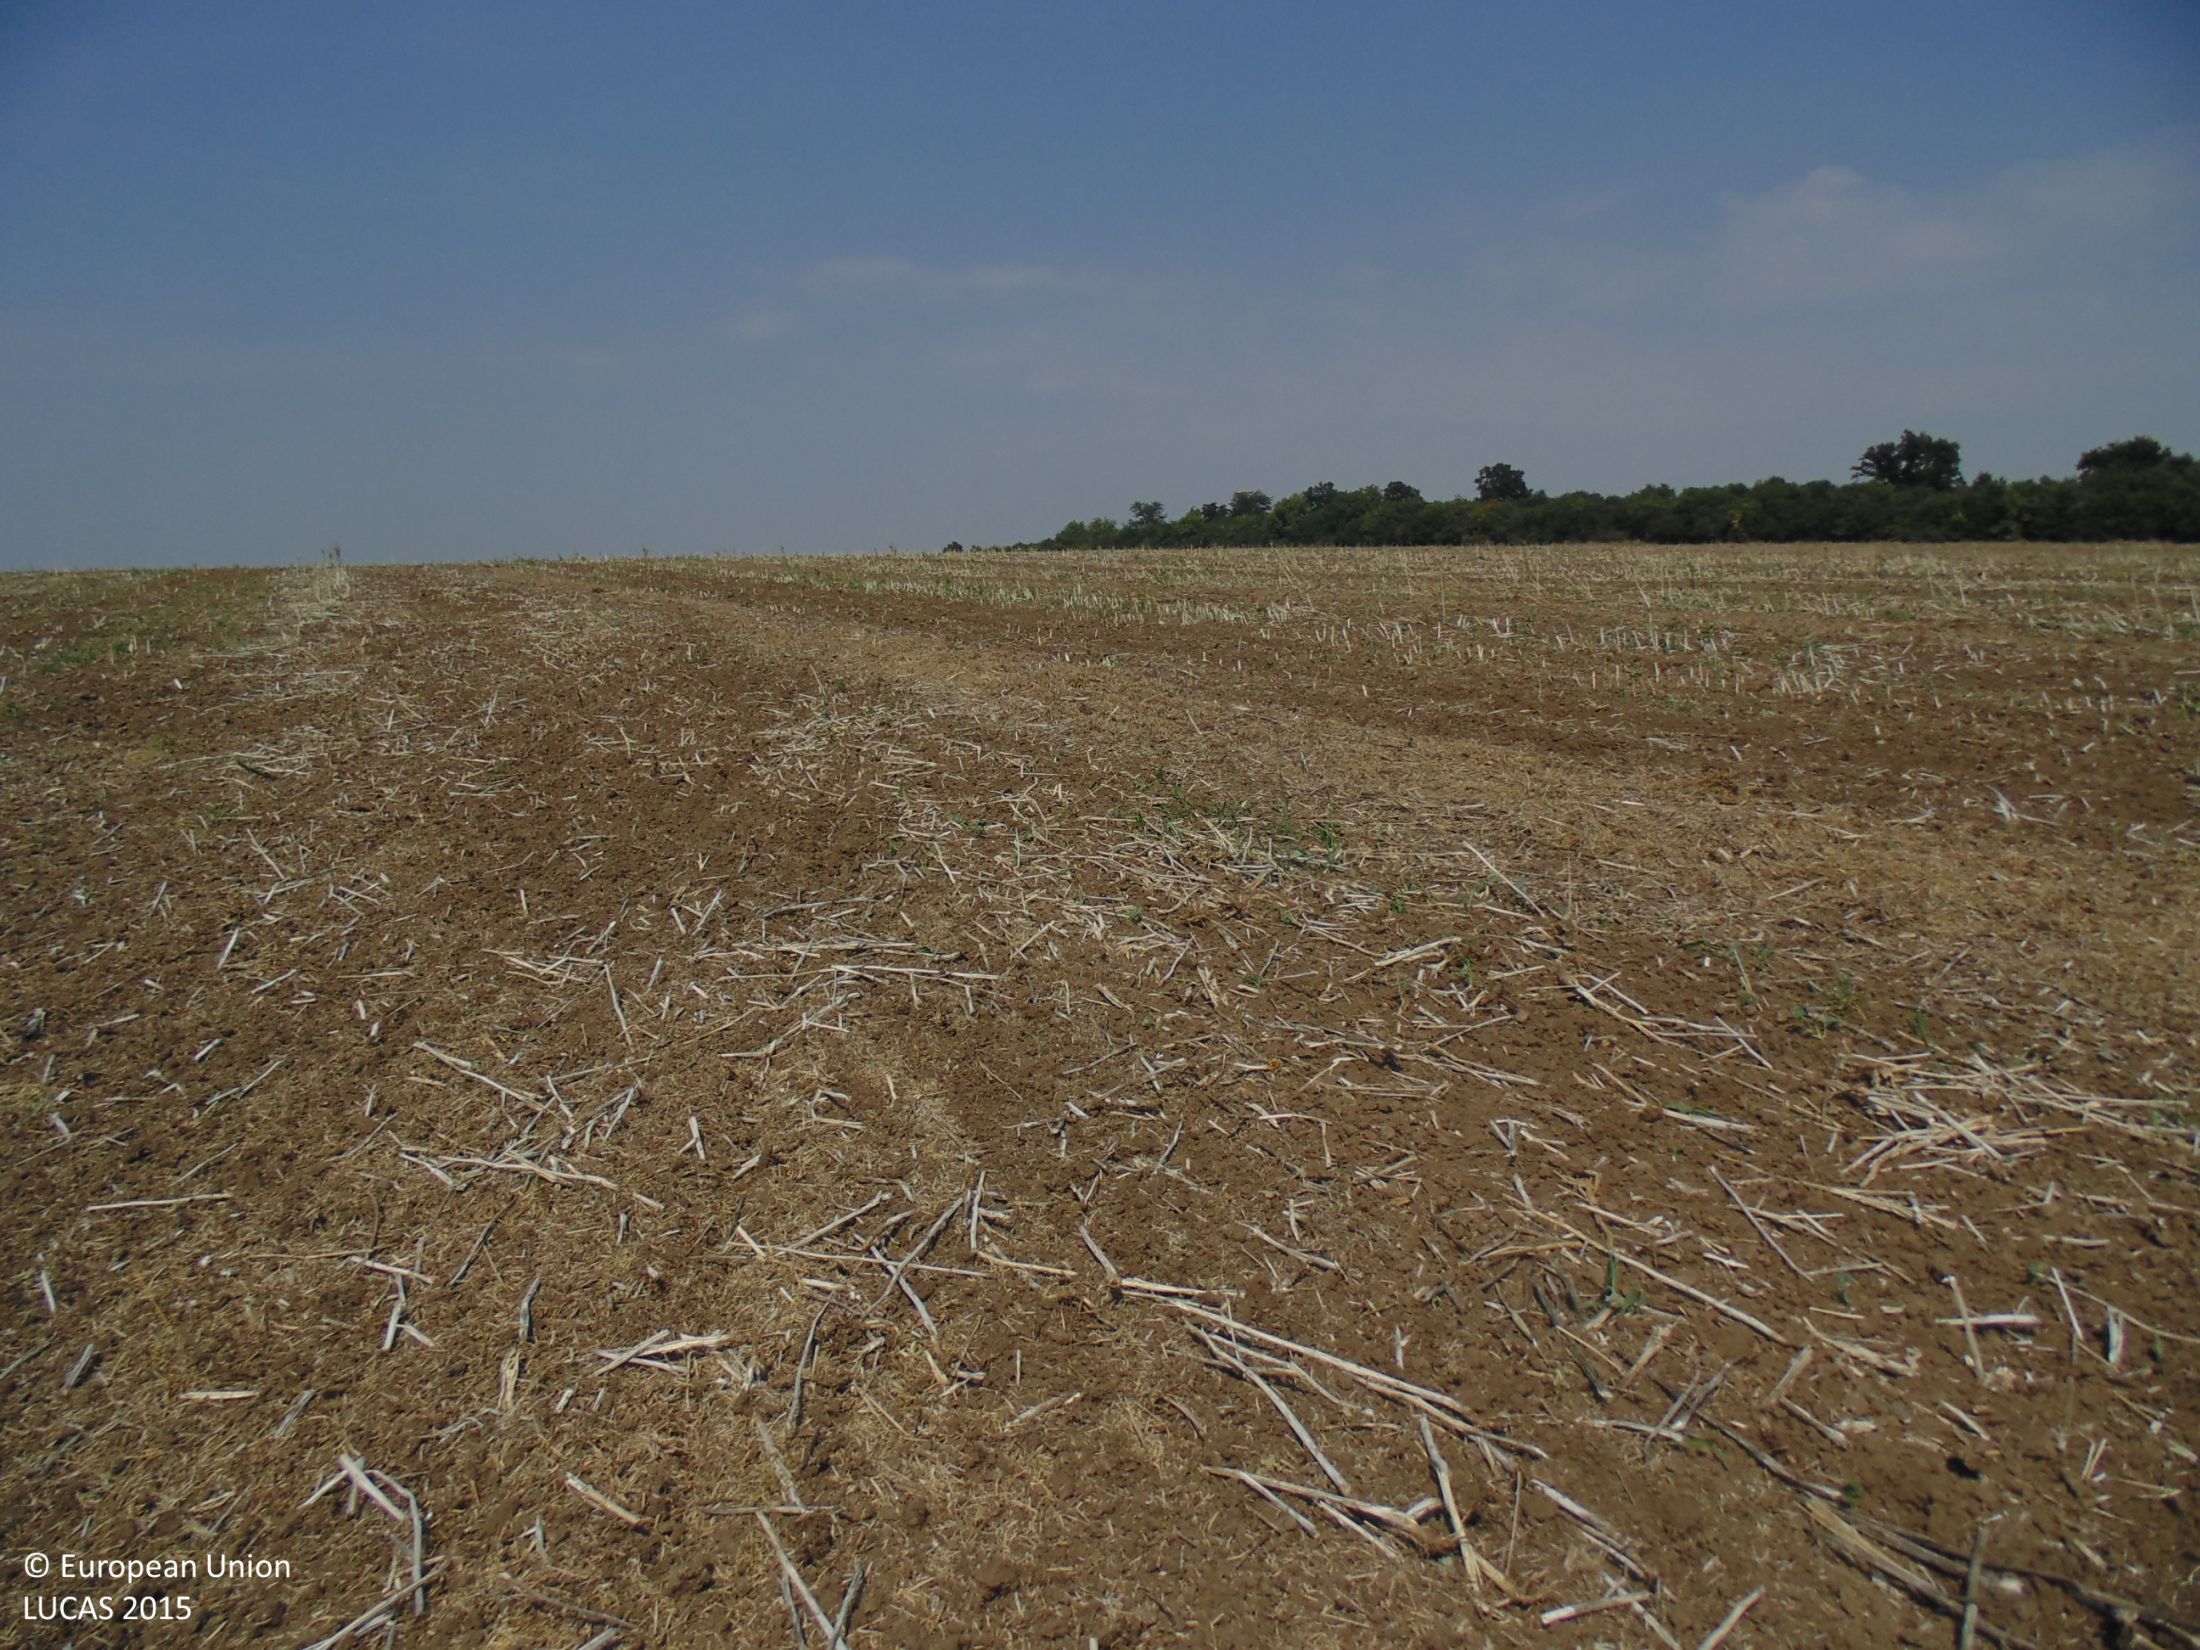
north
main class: Cropland
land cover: Rape and turnip rape
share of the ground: < 10 %
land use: Agriculture (excluding fallow land and kitchen gardens)
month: August
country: BG
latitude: 43.9795
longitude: 27.2464
